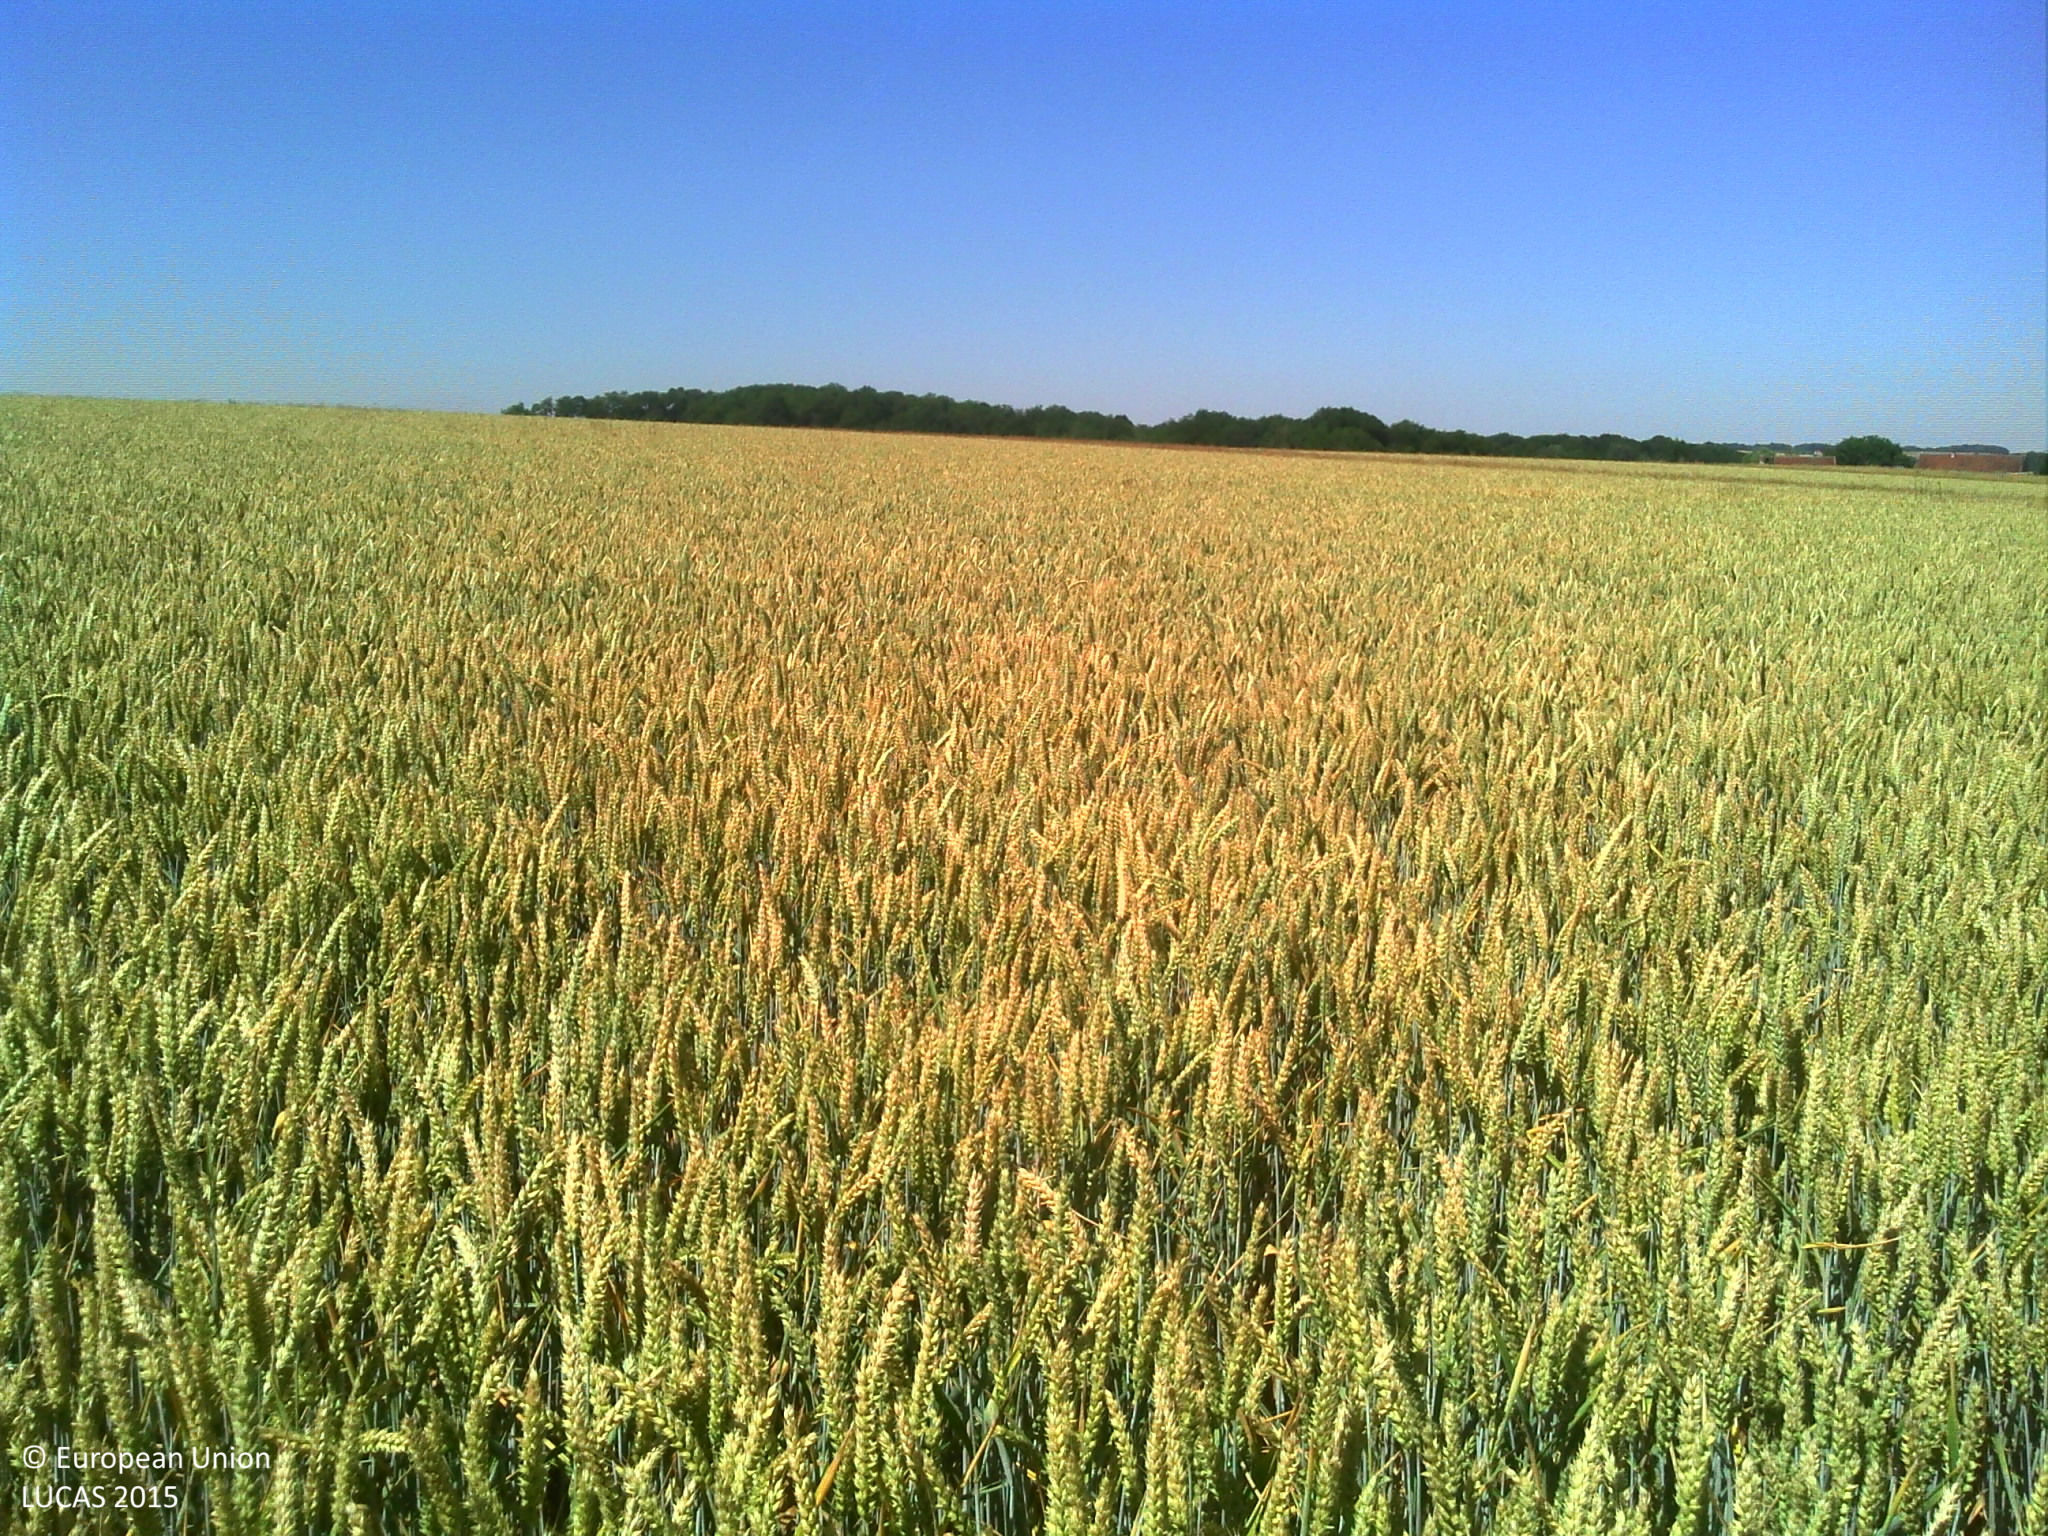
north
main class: Cropland
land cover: Common wheat
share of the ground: > 75 %
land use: Agriculture (excluding fallow land and kitchen gardens)
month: June
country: FR
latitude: 48.9641
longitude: 3.3956
